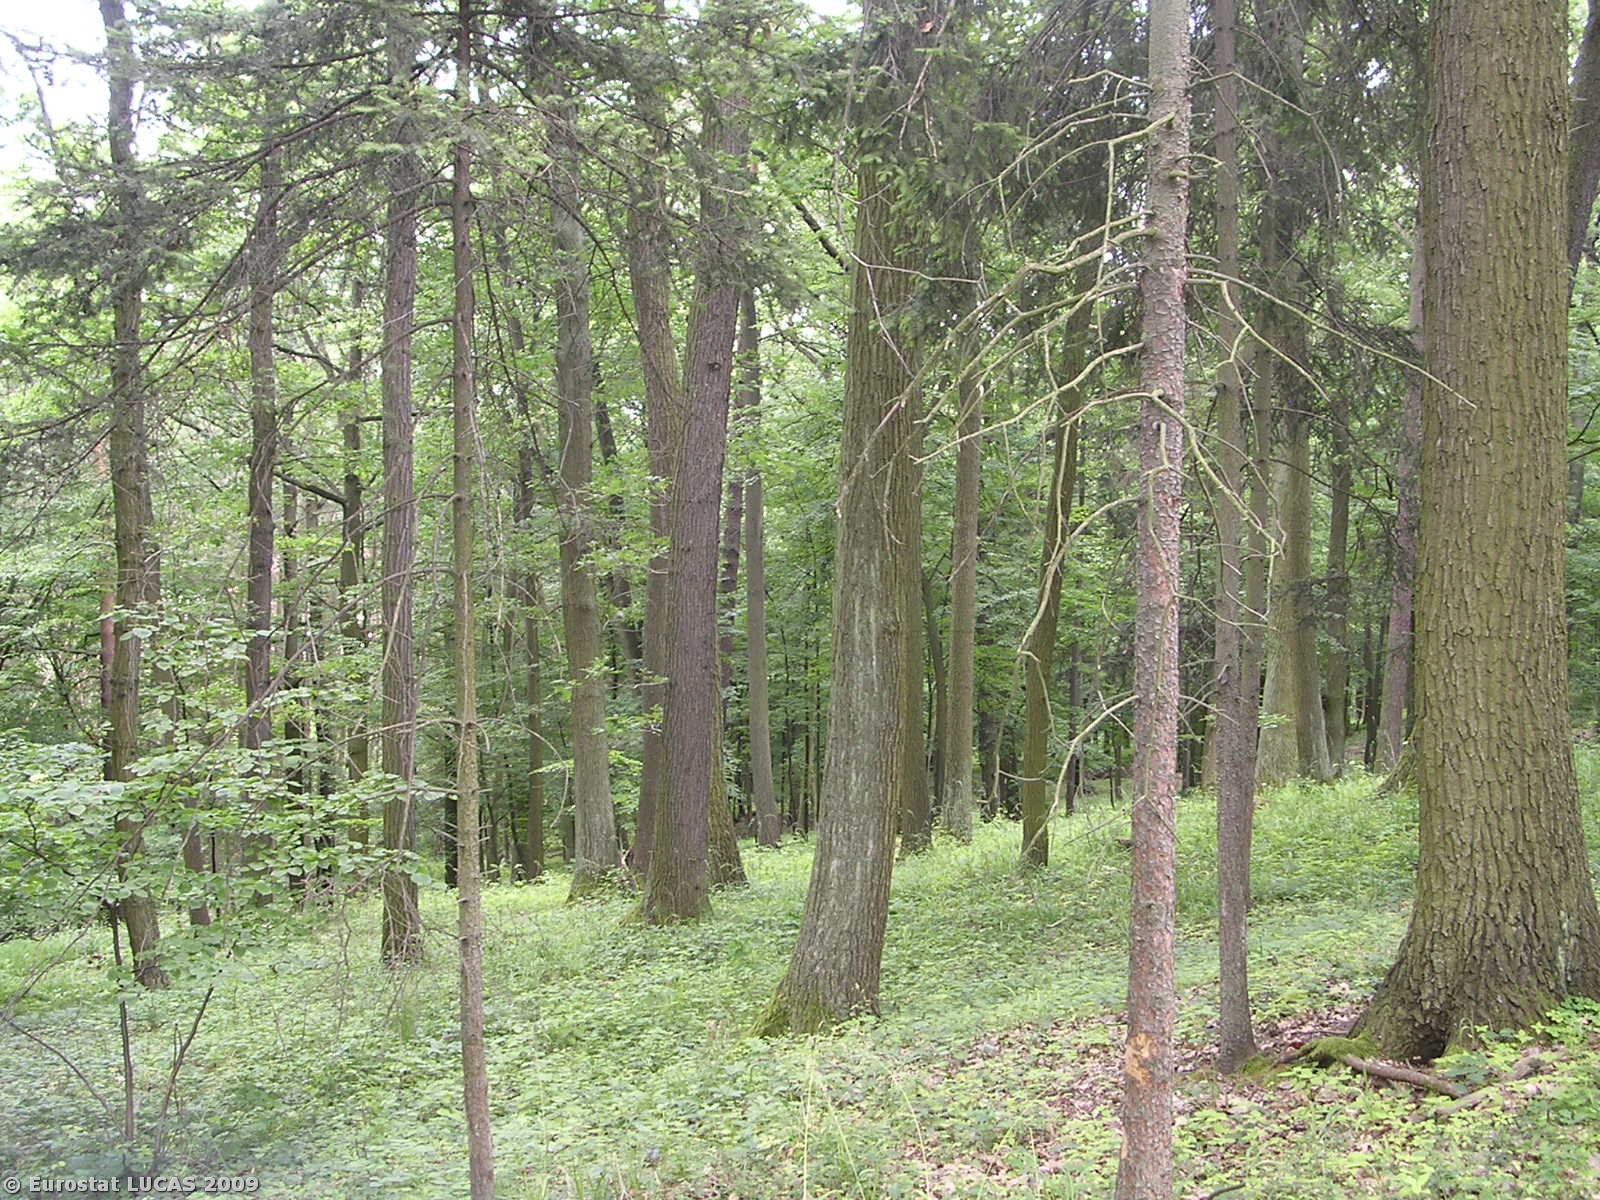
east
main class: Woodland
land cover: Broadleaved woodland
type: acidophilous oak and oak-birch forest
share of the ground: > 75 %
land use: Forestry
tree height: > 5 m
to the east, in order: Broadleaved woodland; Mixed woodland; Tracks; Broadleaved woodland; Ditches and canals; Broadleaved woodland; Fences; Artificial constructions in urban areas; Fences; Grass margins; Tracks; Grassland with sparse tree/shrub cover; Other leguminous and mixtures for fodder
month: June
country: CZ
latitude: 50.5932
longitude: 14.1968
